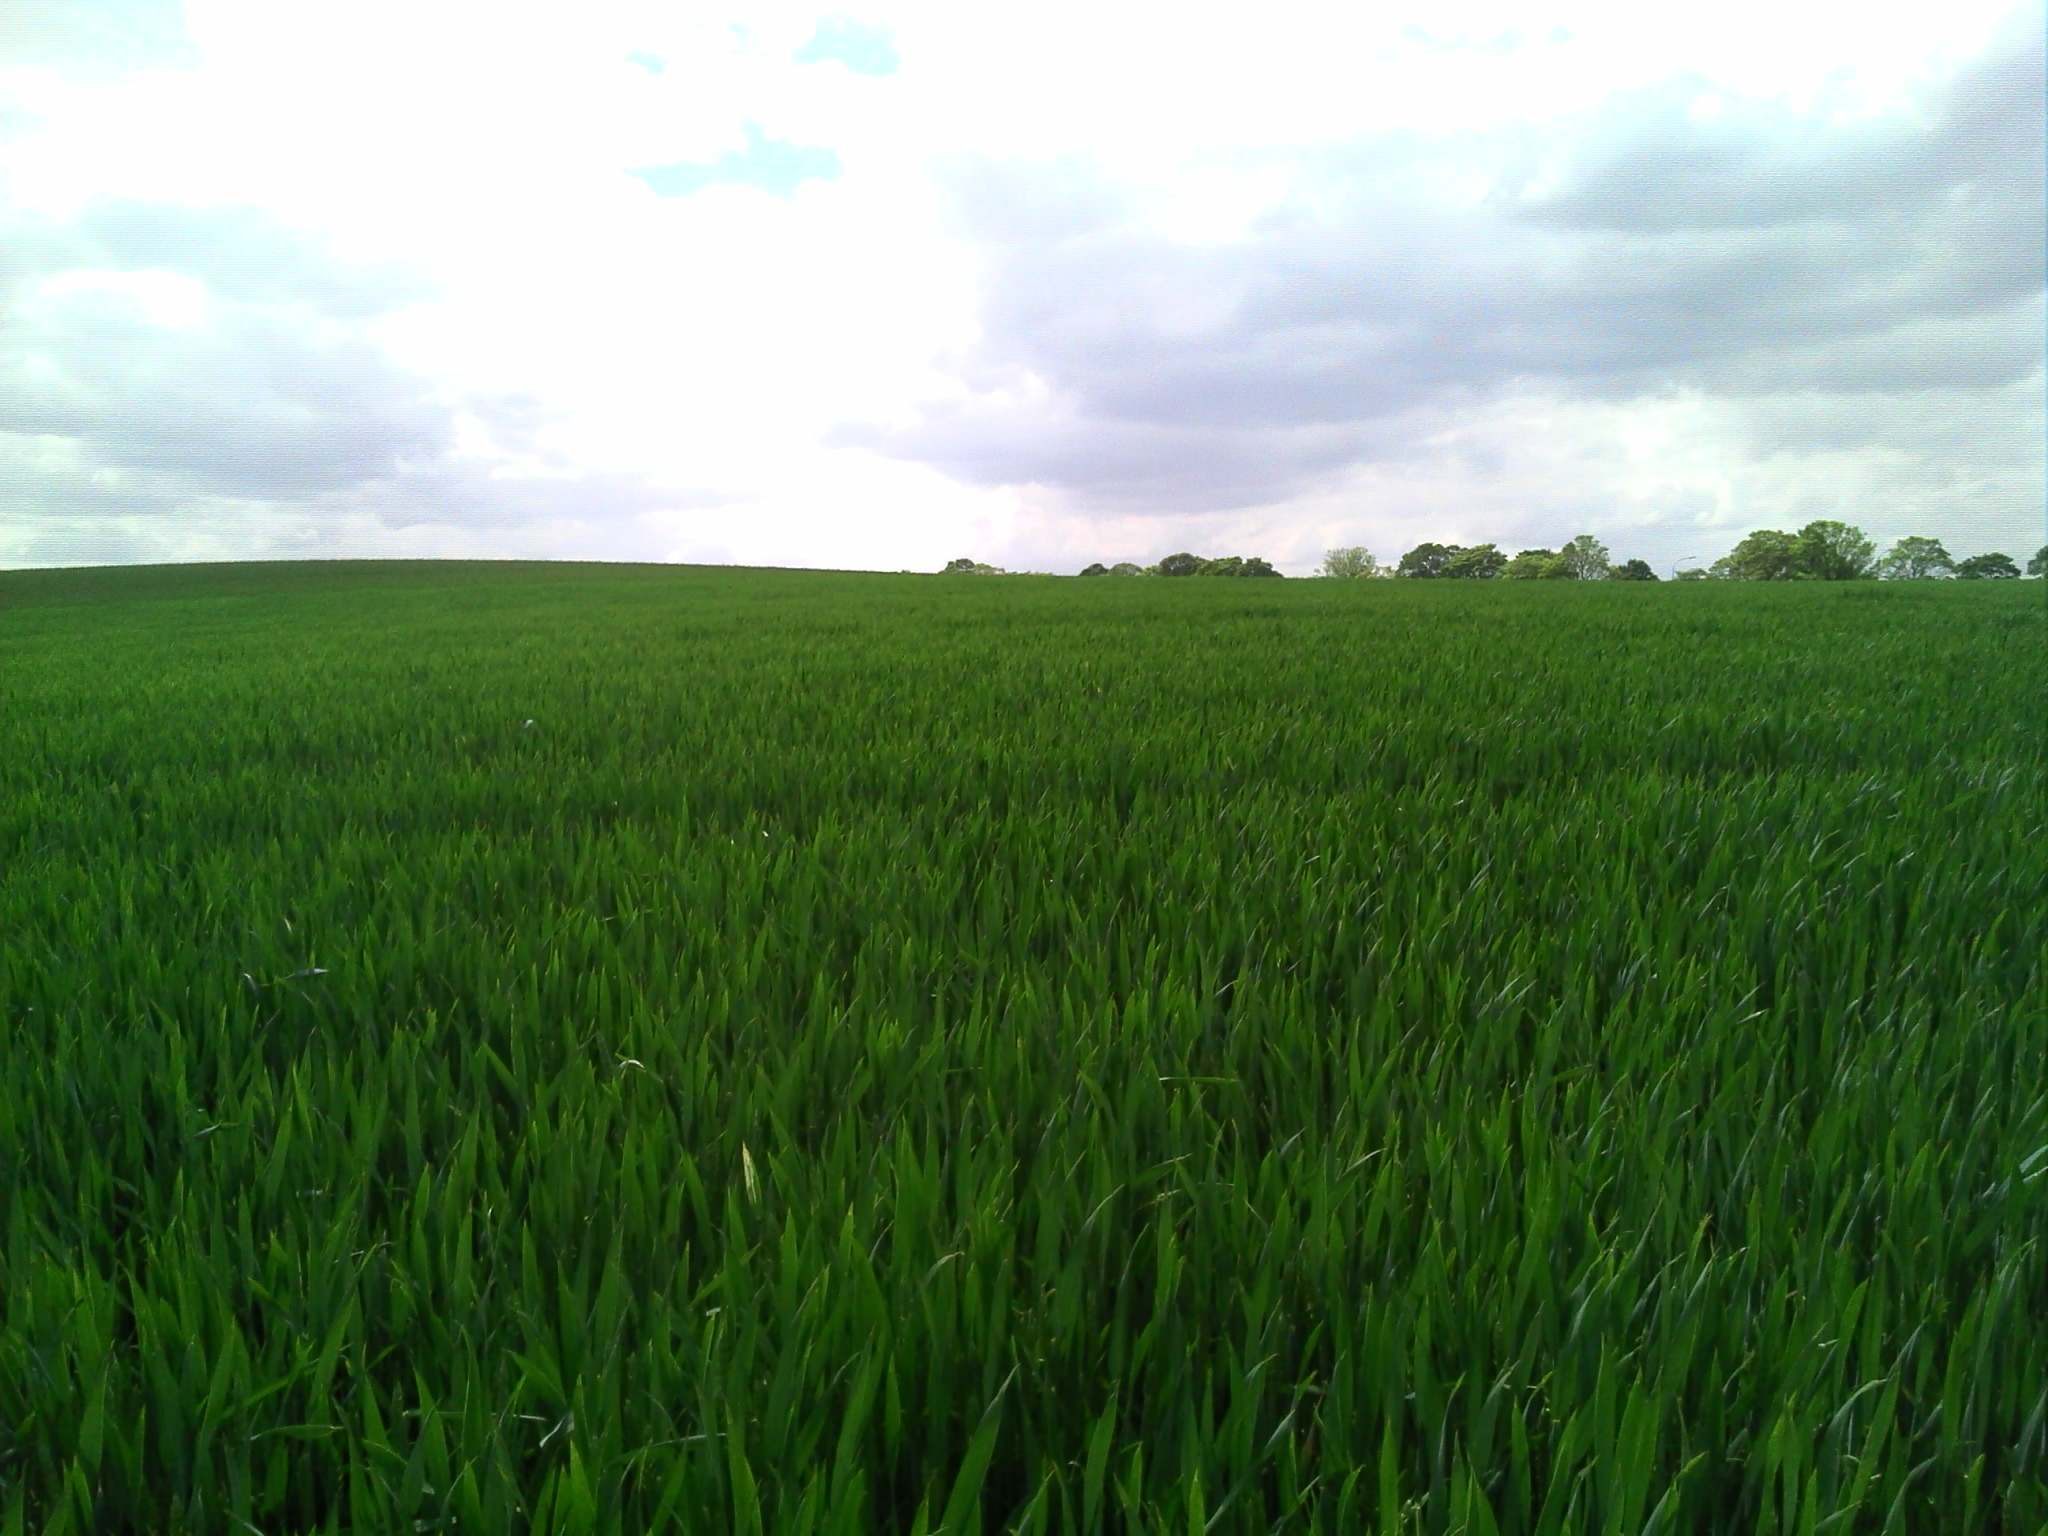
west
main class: Cropland
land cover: Common wheat
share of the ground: > 75 %
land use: Agriculture (excluding fallow land and kitchen gardens)
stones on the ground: < 10 %
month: June
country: BE
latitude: 50.5067
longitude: 4.5957
